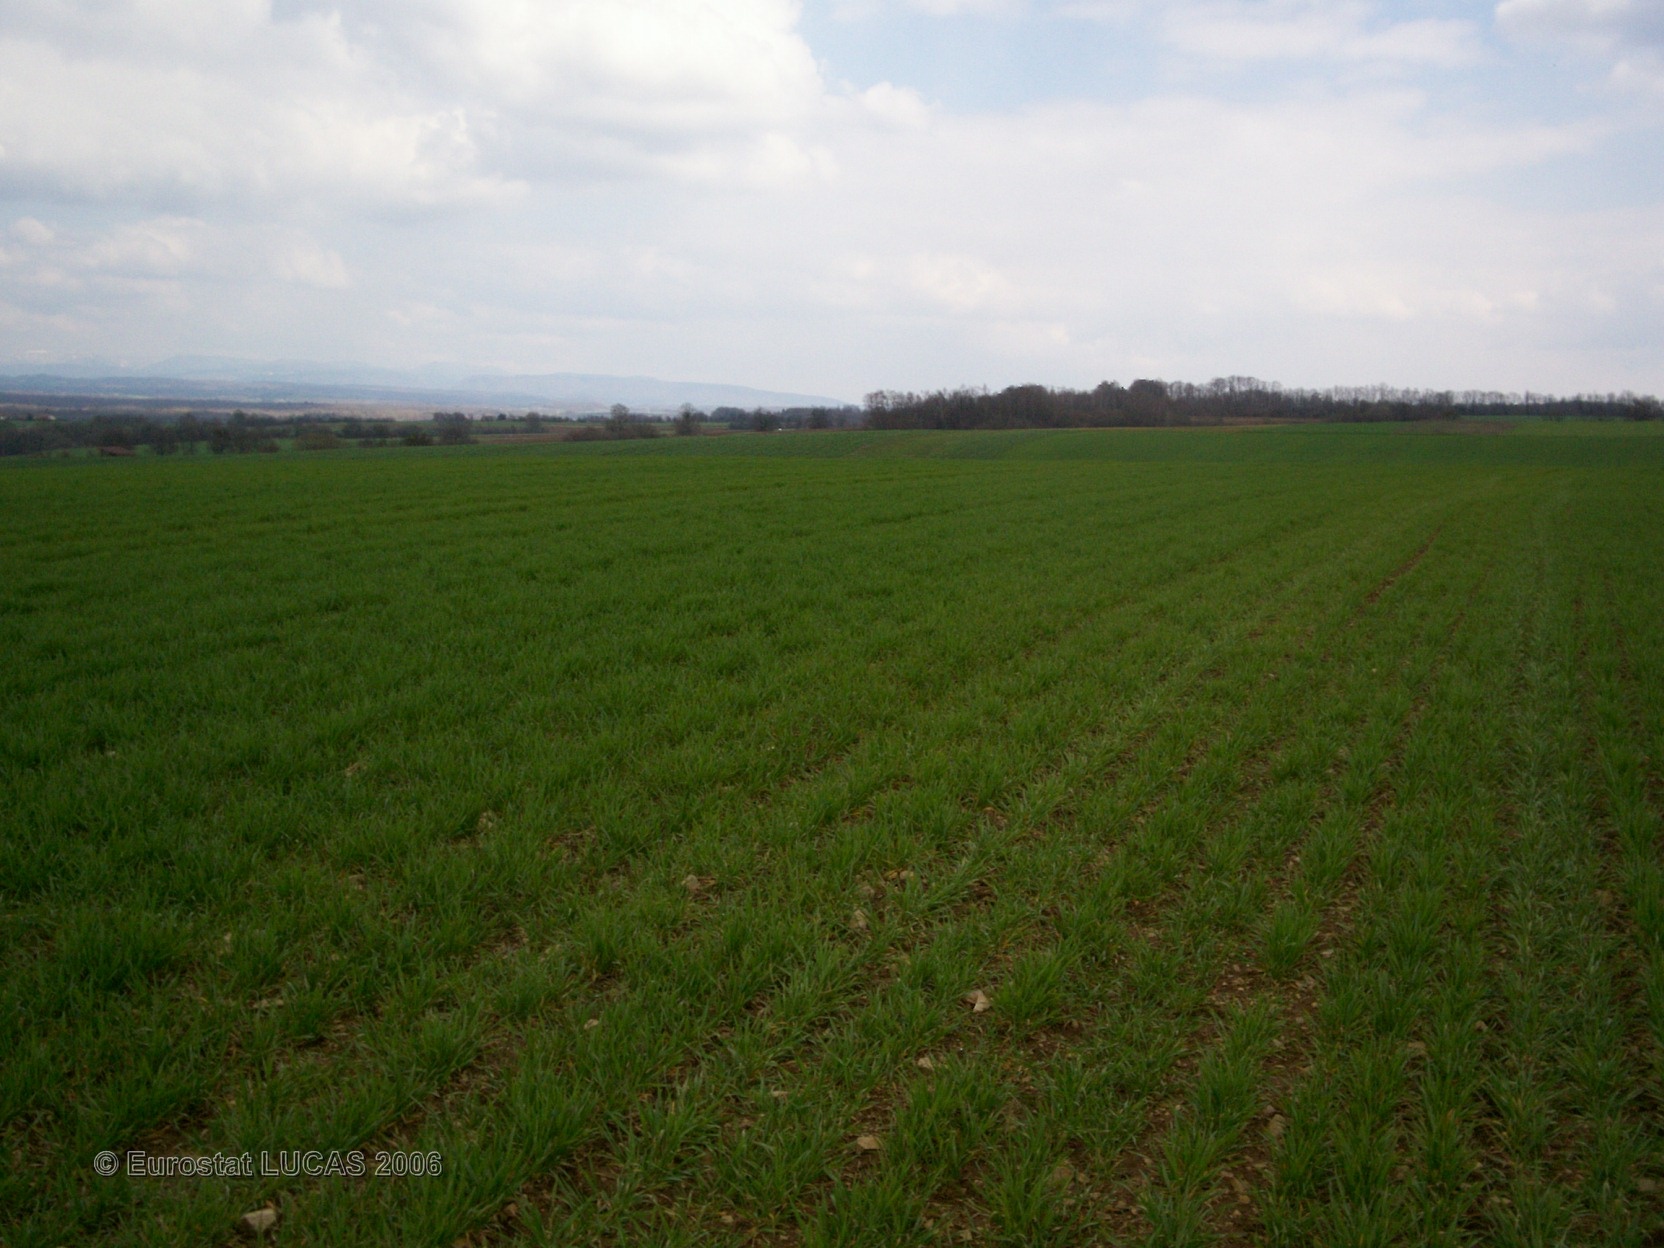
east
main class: Cropland
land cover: Common wheat
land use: Agriculture (excluding fallow land and kitchen gardens)
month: April
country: FR
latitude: 47.7491
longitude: 6.3599
